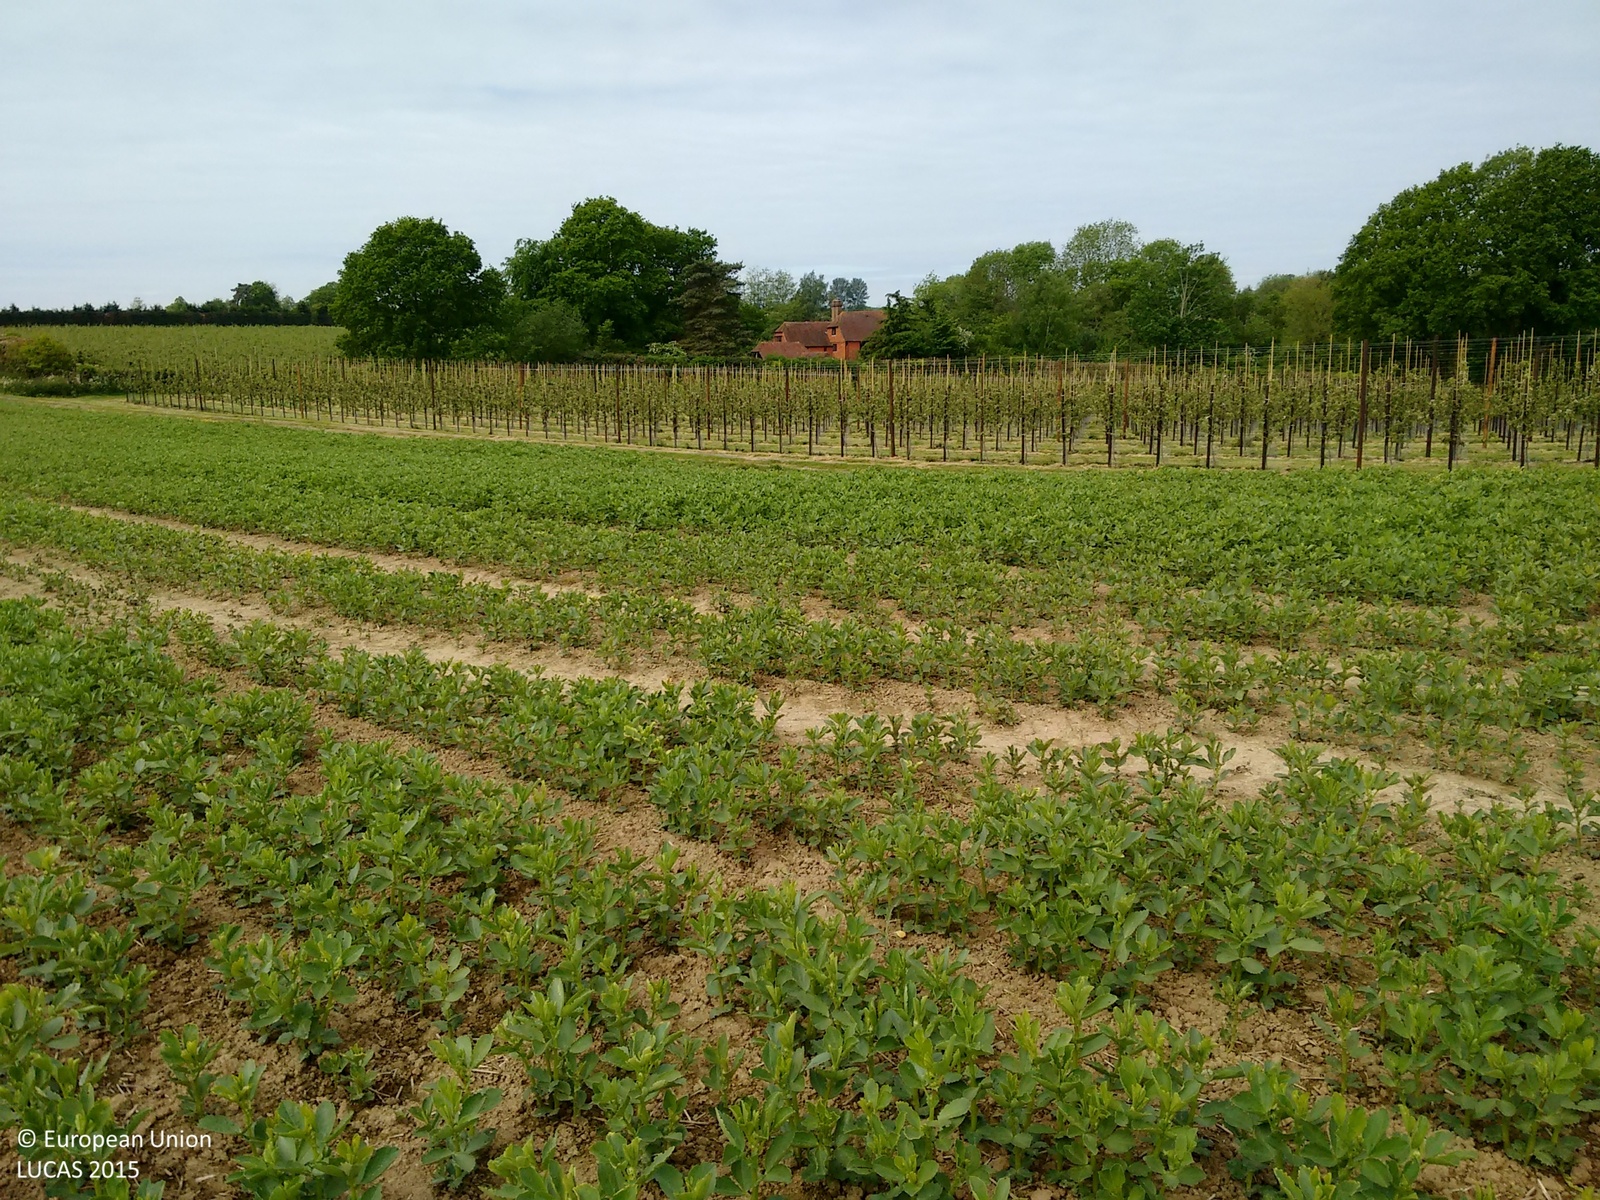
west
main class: Cropland
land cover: Dry pulses
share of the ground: > 75 %
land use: Agriculture (excluding fallow land and kitchen gardens)
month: May
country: GB
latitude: 51.1373
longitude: 0.4099
